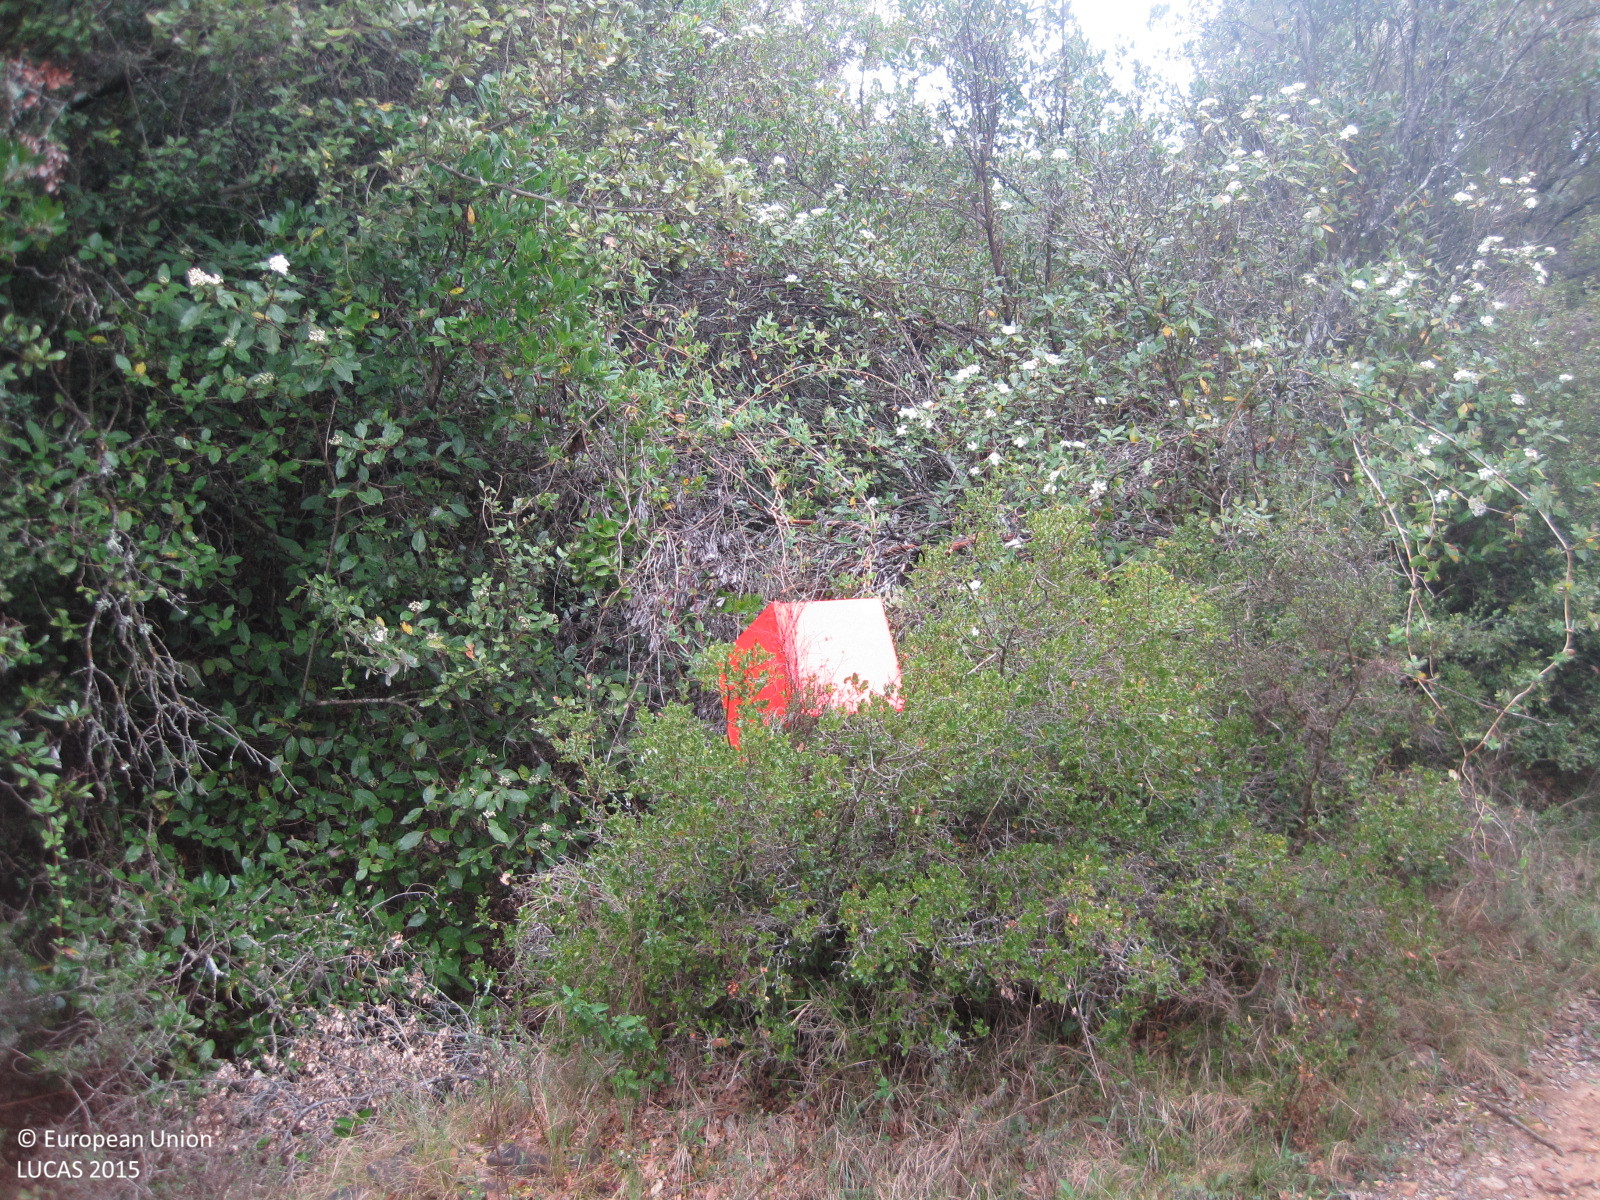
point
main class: Woodland
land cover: Broadleaved woodland
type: broadleaved evergreen forest
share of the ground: > 75 %
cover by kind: broadleaved forest trees 100 %
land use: Forestry
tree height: > 5 m
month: April
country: ES
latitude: 42.6784
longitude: -2.2107
